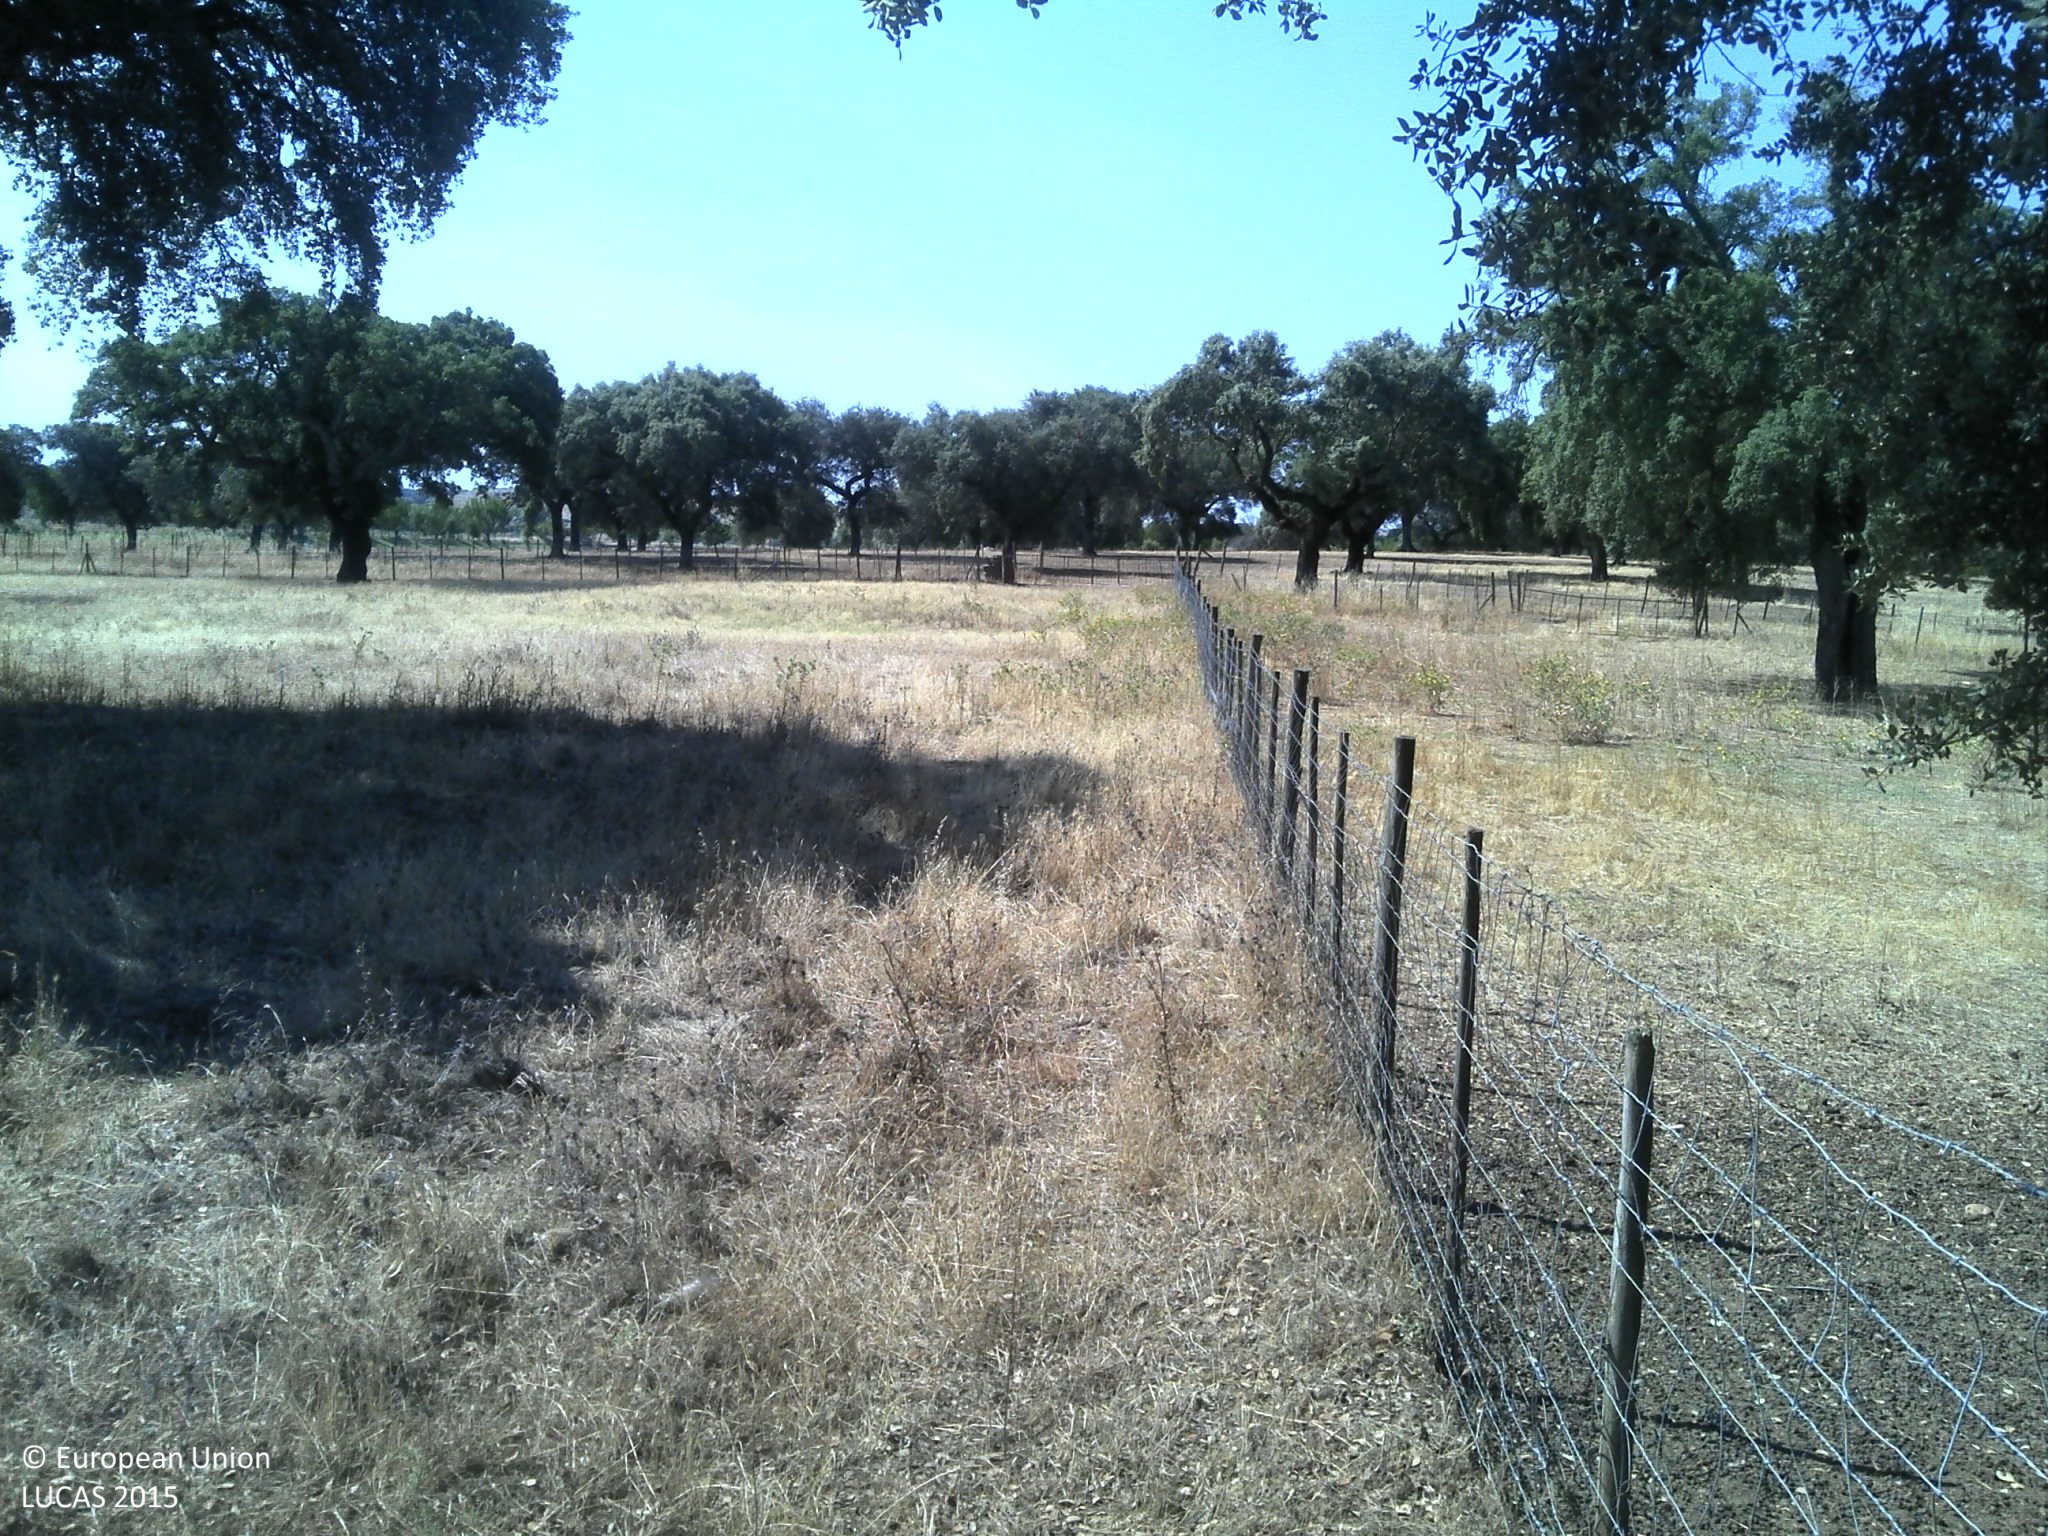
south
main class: Woodland
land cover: Broadleaved woodland
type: broadleaved evergreen forest
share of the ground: 25 - 50 %
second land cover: Grassland without tree/shrub cover
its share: 25 - 50 %
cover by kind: broadleaved forest trees 40 %, herbaceous plants 40 %, unconsolidated bare surface 15 %
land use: Forestry
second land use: Agriculture (excluding fallow land and kitchen gardens)
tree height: > 5 m
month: June
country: PT
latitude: 39.9036
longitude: -7.0624
